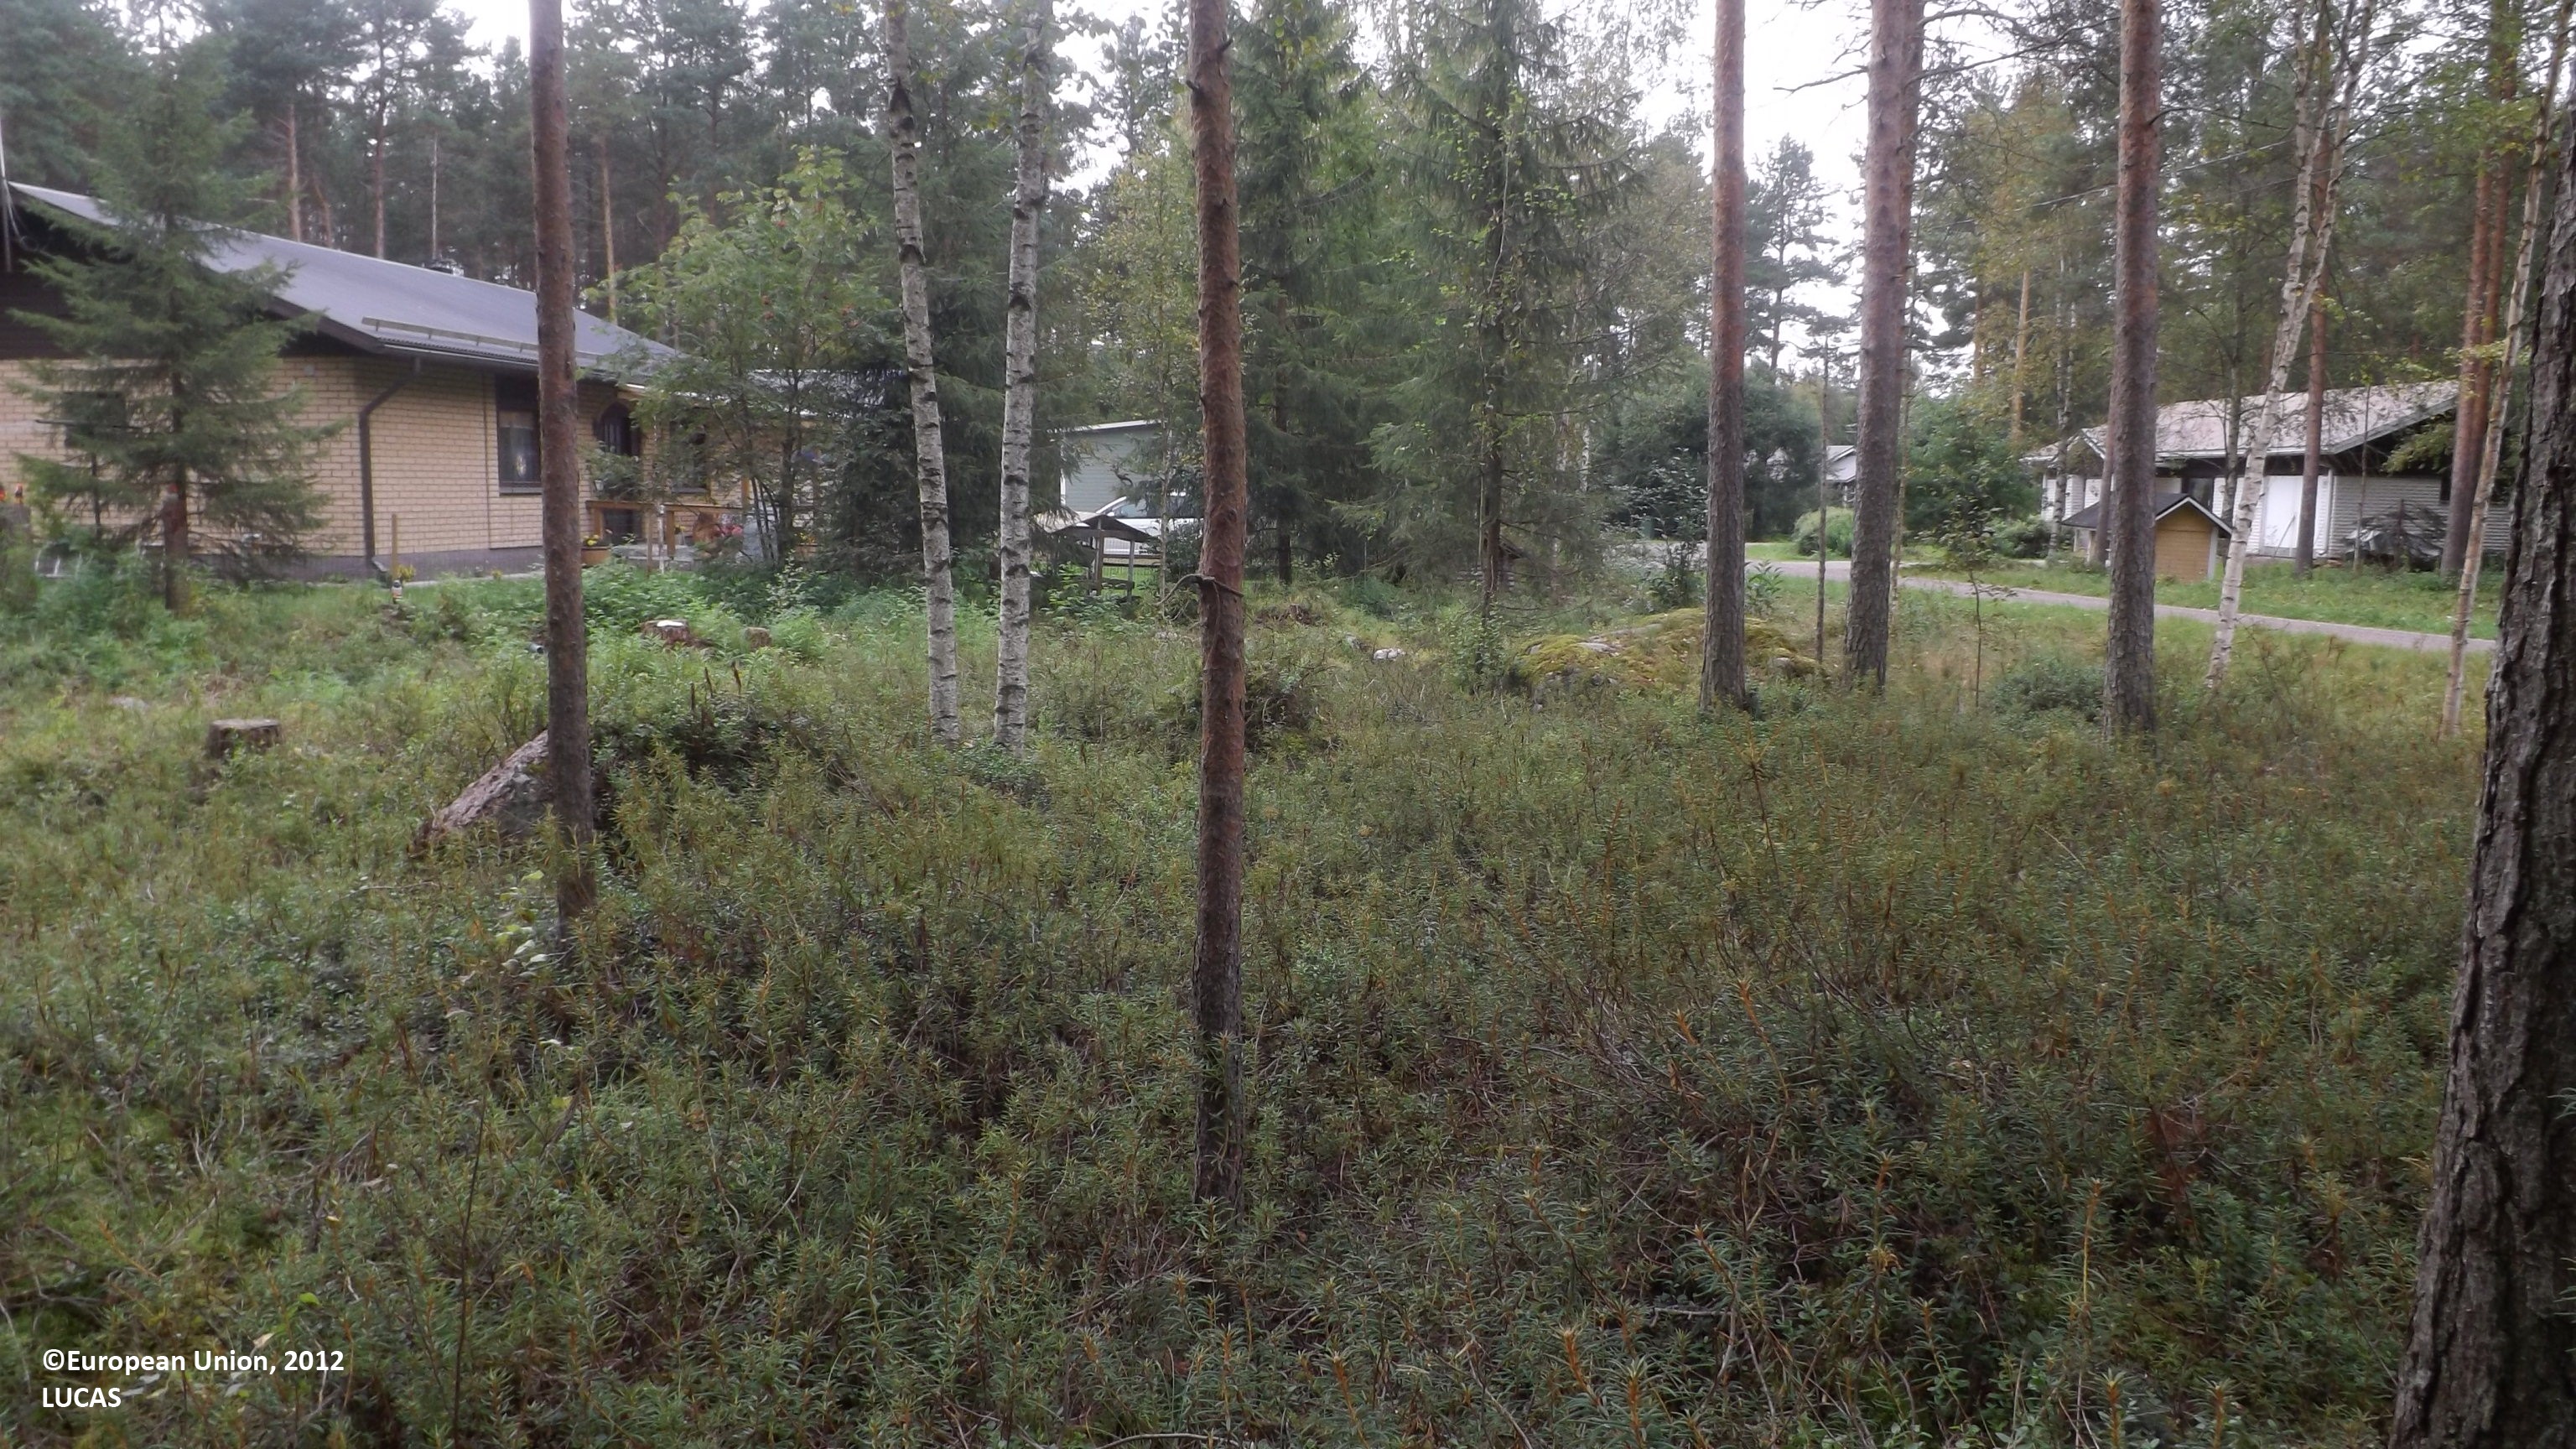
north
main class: Woodland
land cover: Pine dominated coniferous woodland
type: boreal forest
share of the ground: 50 - 75 %
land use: Forestry
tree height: > 5 m
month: August
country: FI
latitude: 63.8970
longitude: 23.8550
